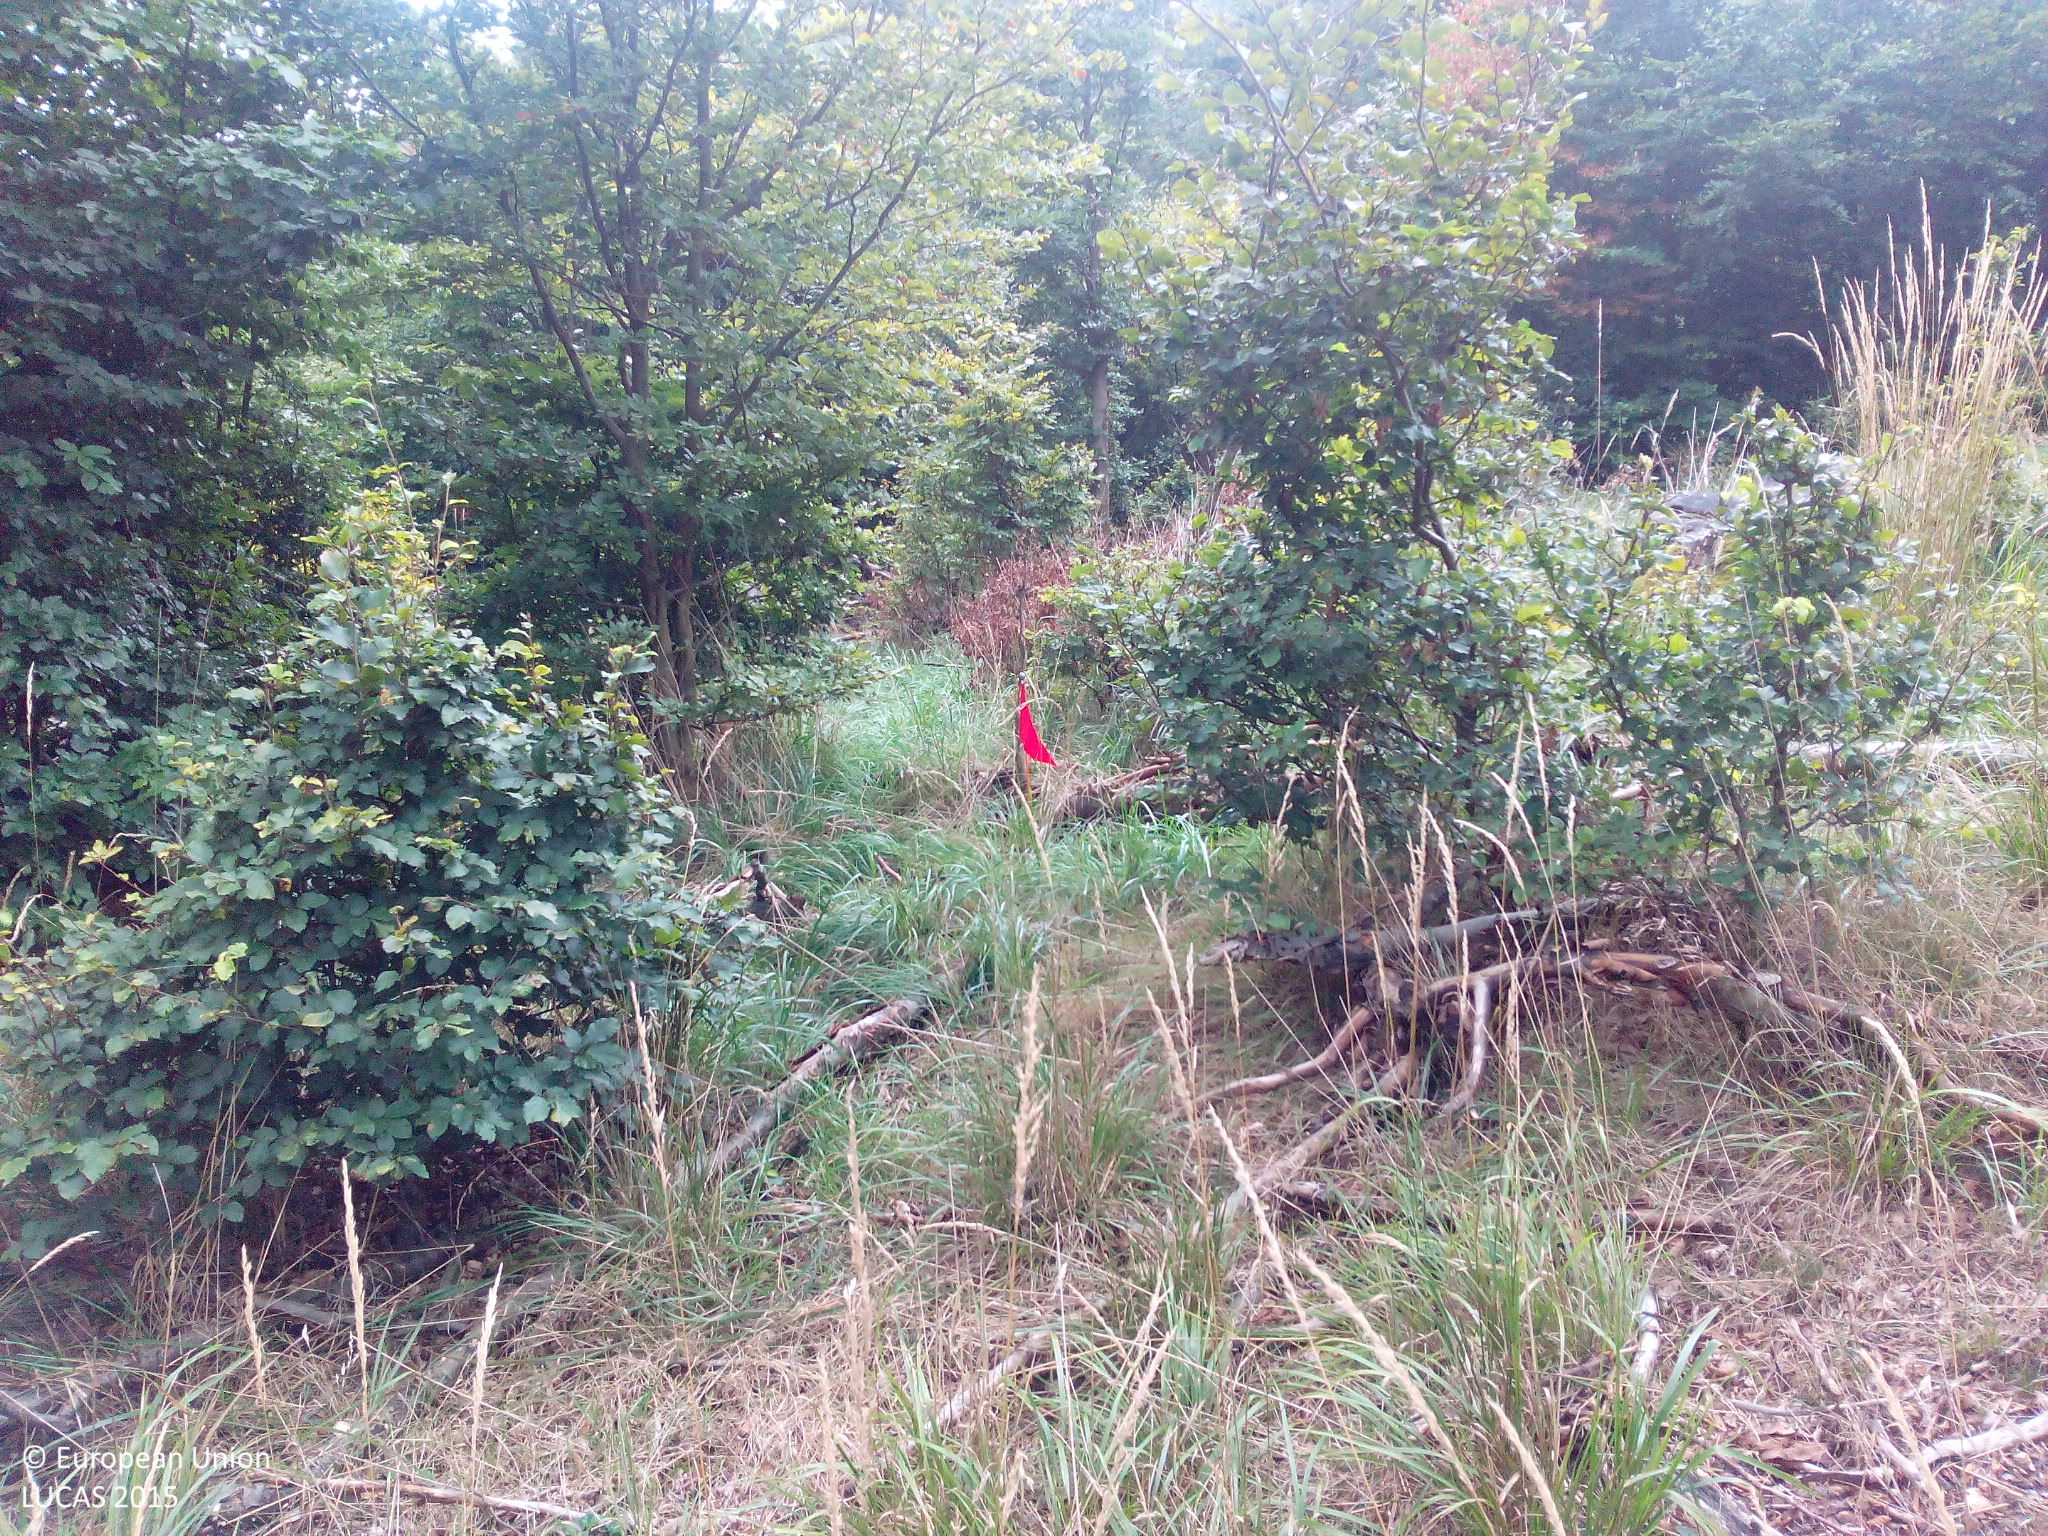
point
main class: Woodland
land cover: Broadleaved woodland
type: beech forest
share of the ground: 50 - 75 %
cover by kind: broadleaved forest trees 70 %, herbaceous plants 30 %
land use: Forestry
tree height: > 5 m
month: September
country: DE
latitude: 51.6005
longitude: 10.9670
